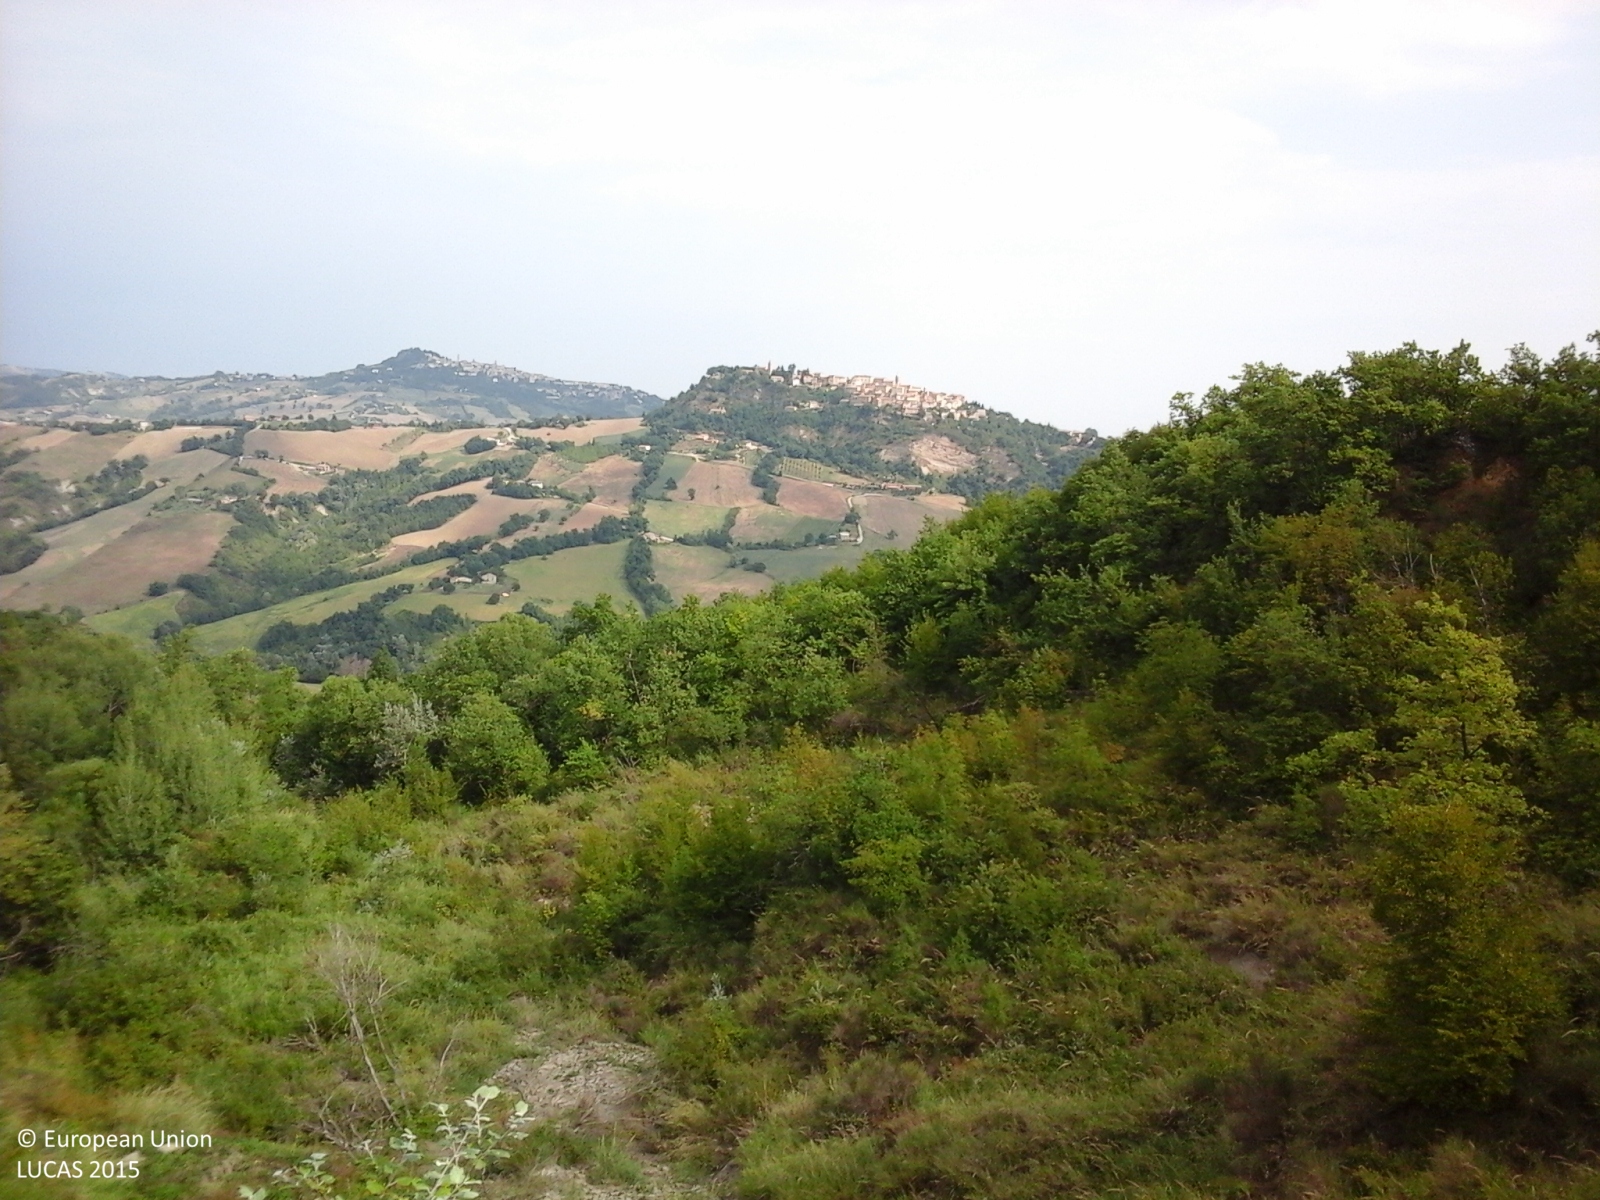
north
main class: Shrubland
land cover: Shrubland without tree cover
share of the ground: > 75 %
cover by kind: shrubs 100 %
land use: Semi-natural and natural areas not in use
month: August
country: IT
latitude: 43.0114
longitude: 13.4381
